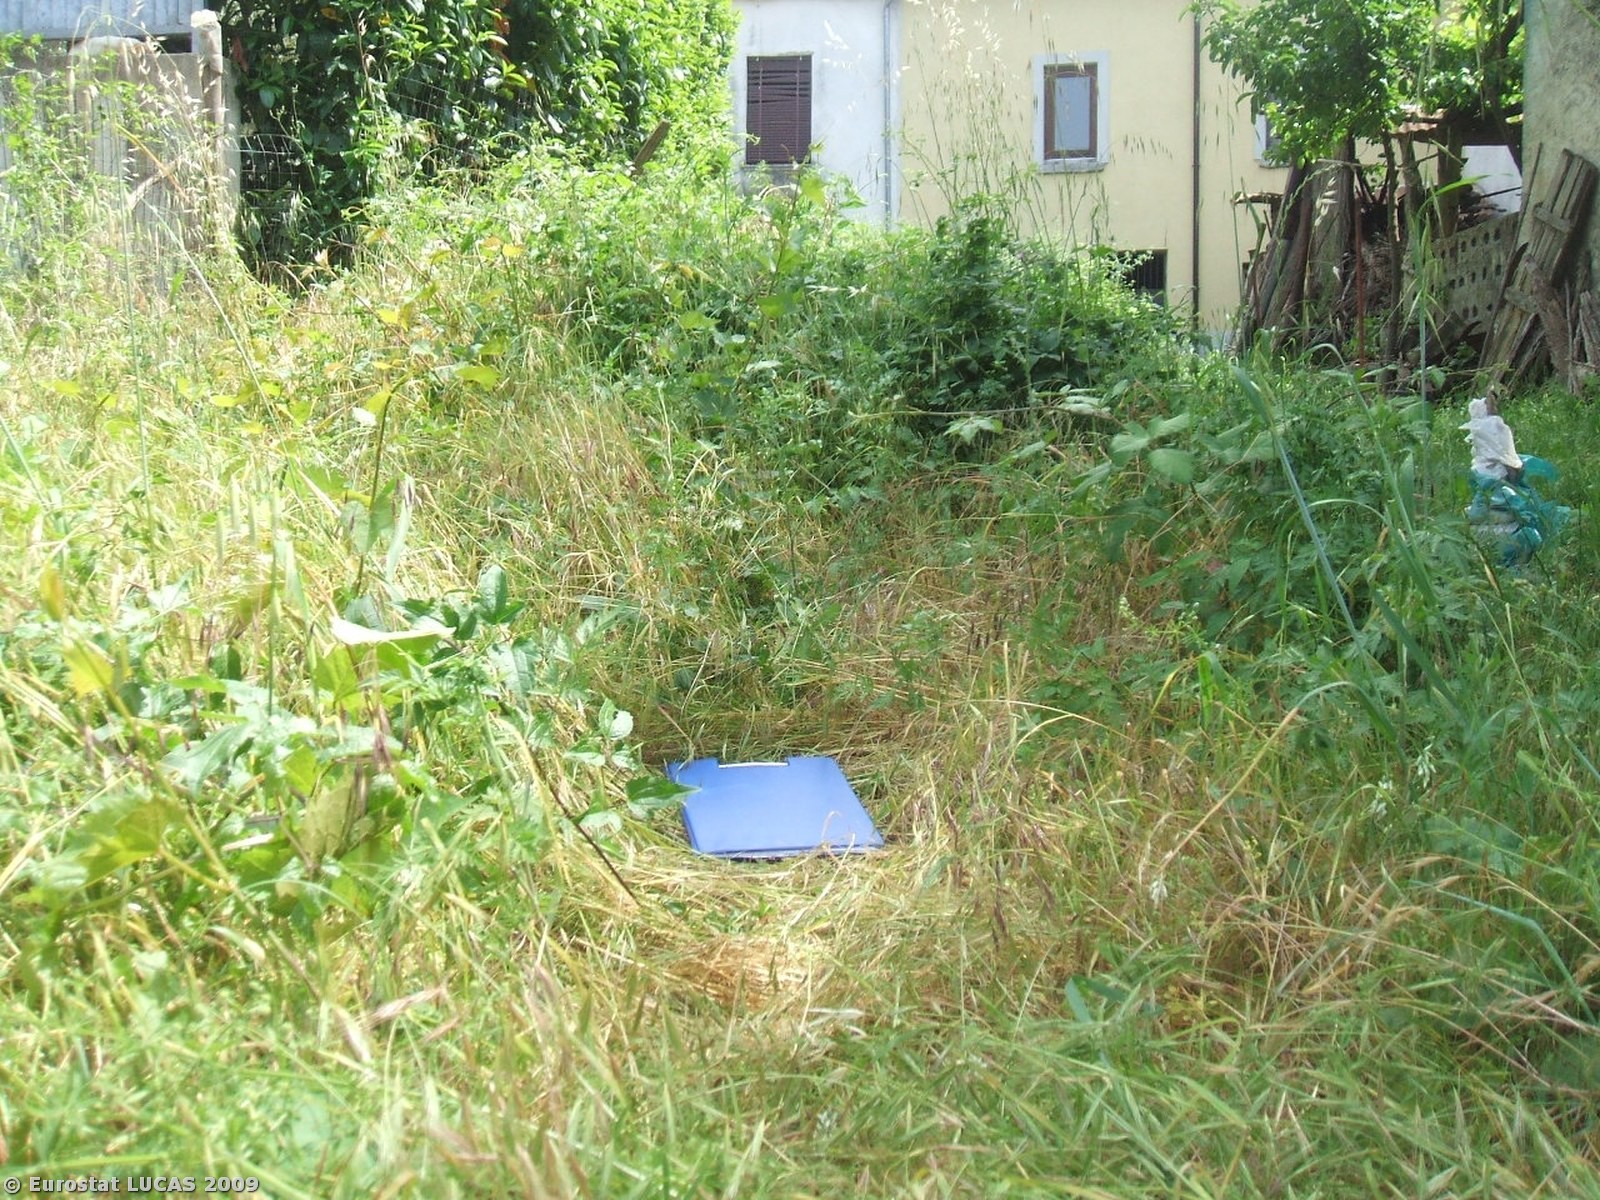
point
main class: Grassland
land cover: Spontaneously vegetated surfaces
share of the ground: > 75 %
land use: Residential
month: May
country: IT
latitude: 40.4545
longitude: 15.5547
